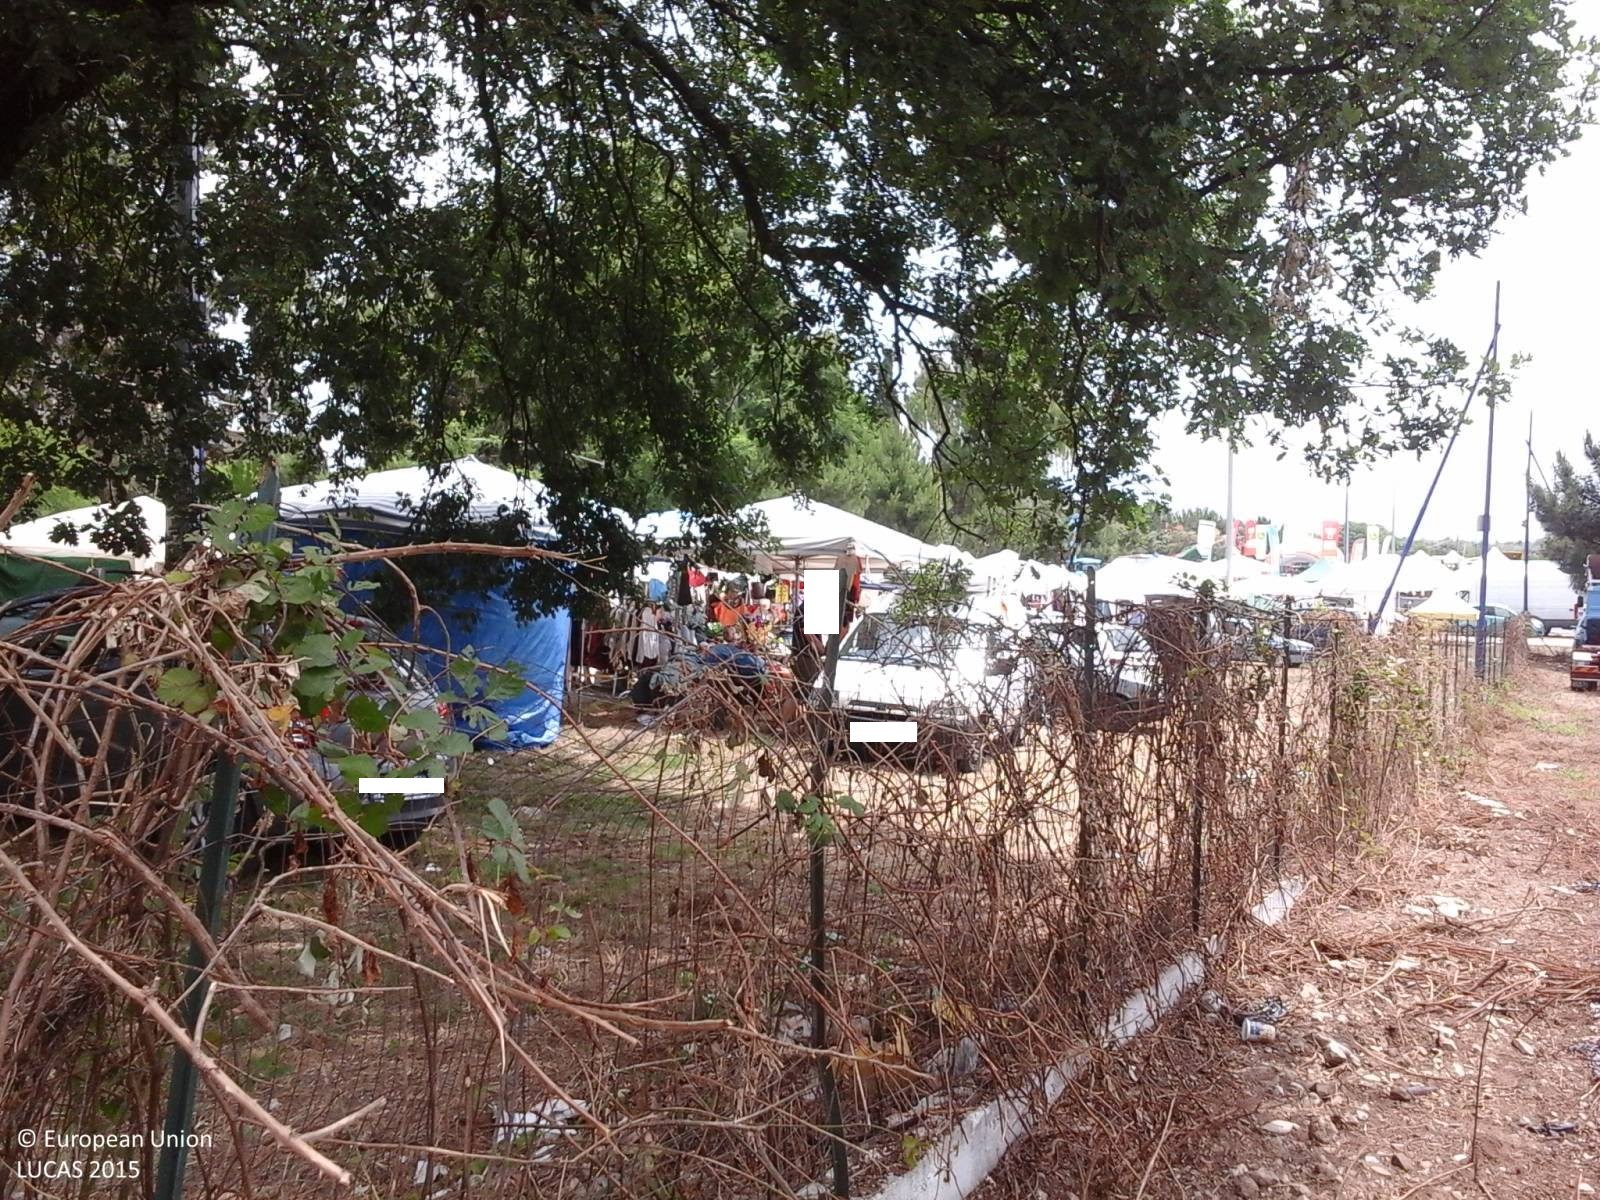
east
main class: Shrubland
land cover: Shrubland without tree cover
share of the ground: > 75 %
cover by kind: shrubs 95 %, unconsolidated bare surface 5 %
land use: Abandoned areas
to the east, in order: Shrubland without tree cover; Fences; Paved roads, cycling and walking lanes; Spontaneously vegetated surfaces; Fences; Paved roads, cycling and walking lanes; Olive groves; Spontaneously vegetated surfaces; Artificial constructions; Abandoned hedges; Electric lines; Paved roads, cycling and walking lanes; Olive groves
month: June
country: IT
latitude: 41.2522
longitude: 14.0537
